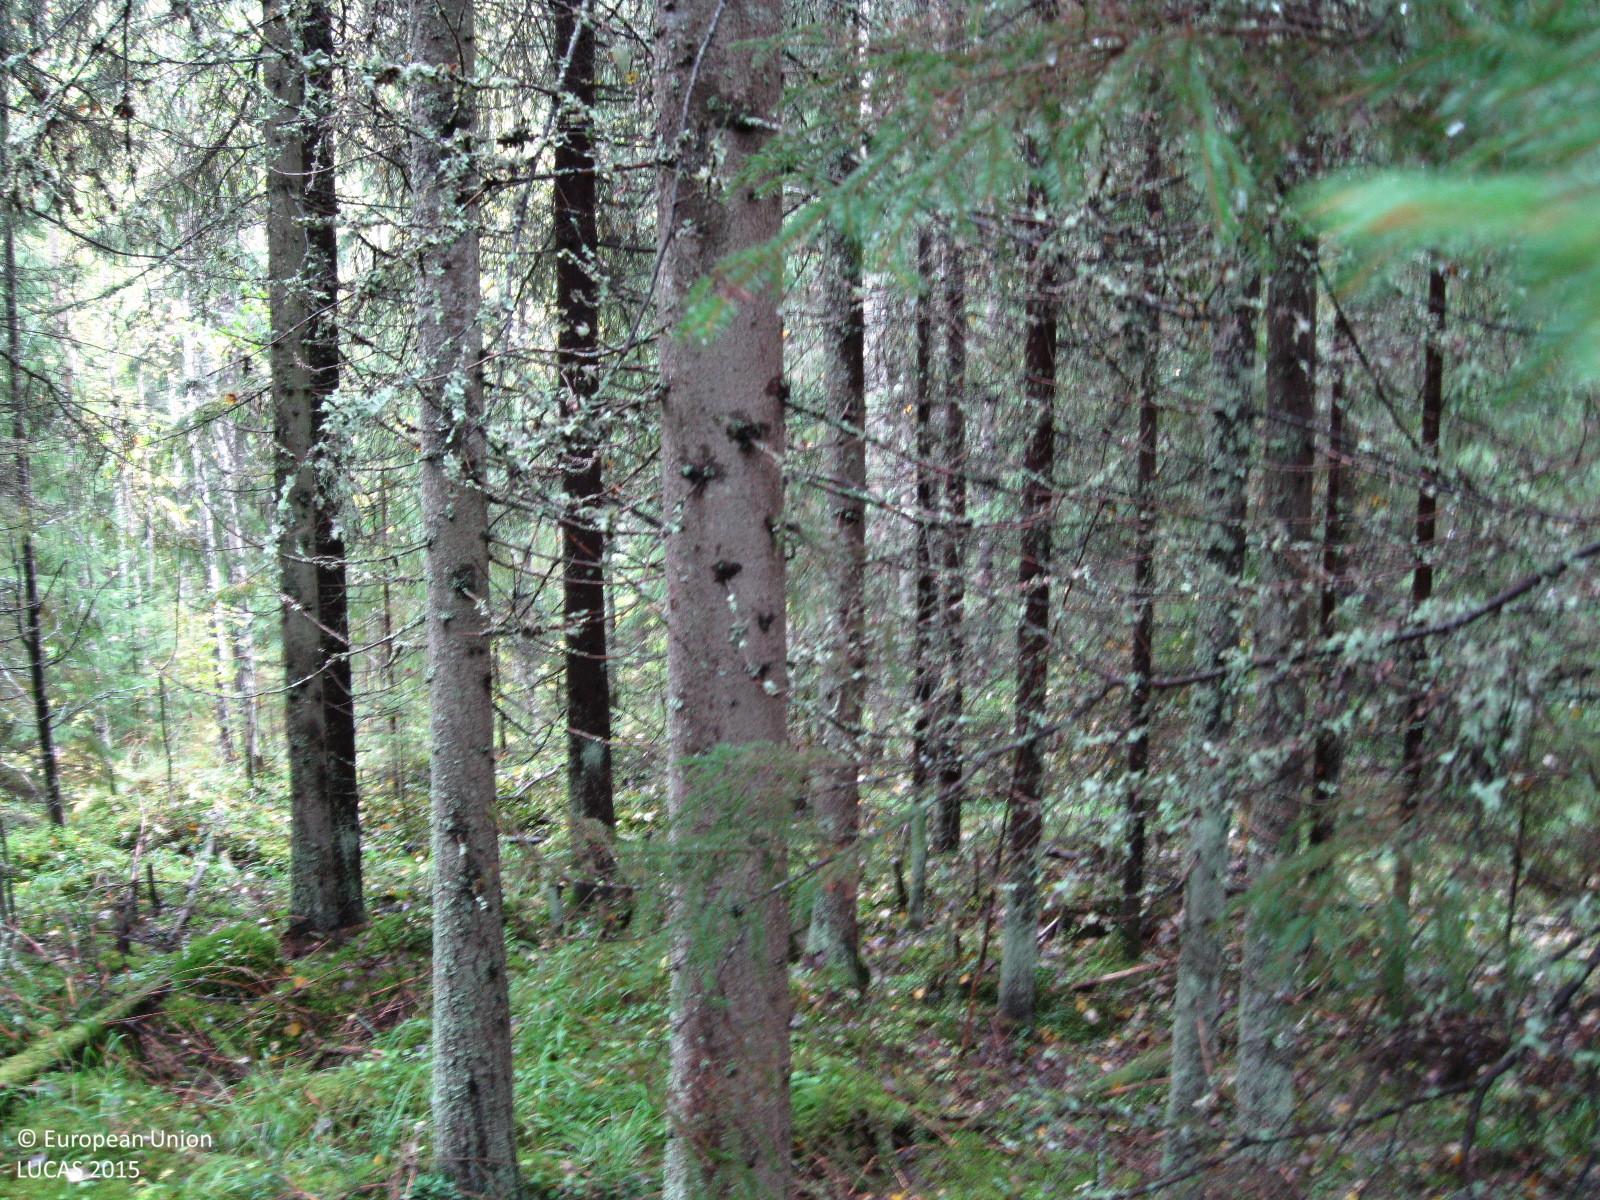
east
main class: Woodland
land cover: Spruce dominated coniferous woodland
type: boreal forest
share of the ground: 50 - 75 %
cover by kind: coniferous forest trees 60 %, herbaceous plants 15 %, broadleaved forest trees 10 %, lichens and mosses 10 %, shrubs 5 %
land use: Forestry
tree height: > 5 m
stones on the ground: > 50 %
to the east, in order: Spruce dominated coniferous woodland; Spruce dominated mixed woodland; Ditches and canals; Grass margins; Spruce dominated coniferous woodland; Ditches and canals; Spruce dominated coniferous woodland; Broadleaved woodland; Spruce dominated coniferous woodland
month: September
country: FI
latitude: 60.7485
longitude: 24.8438
